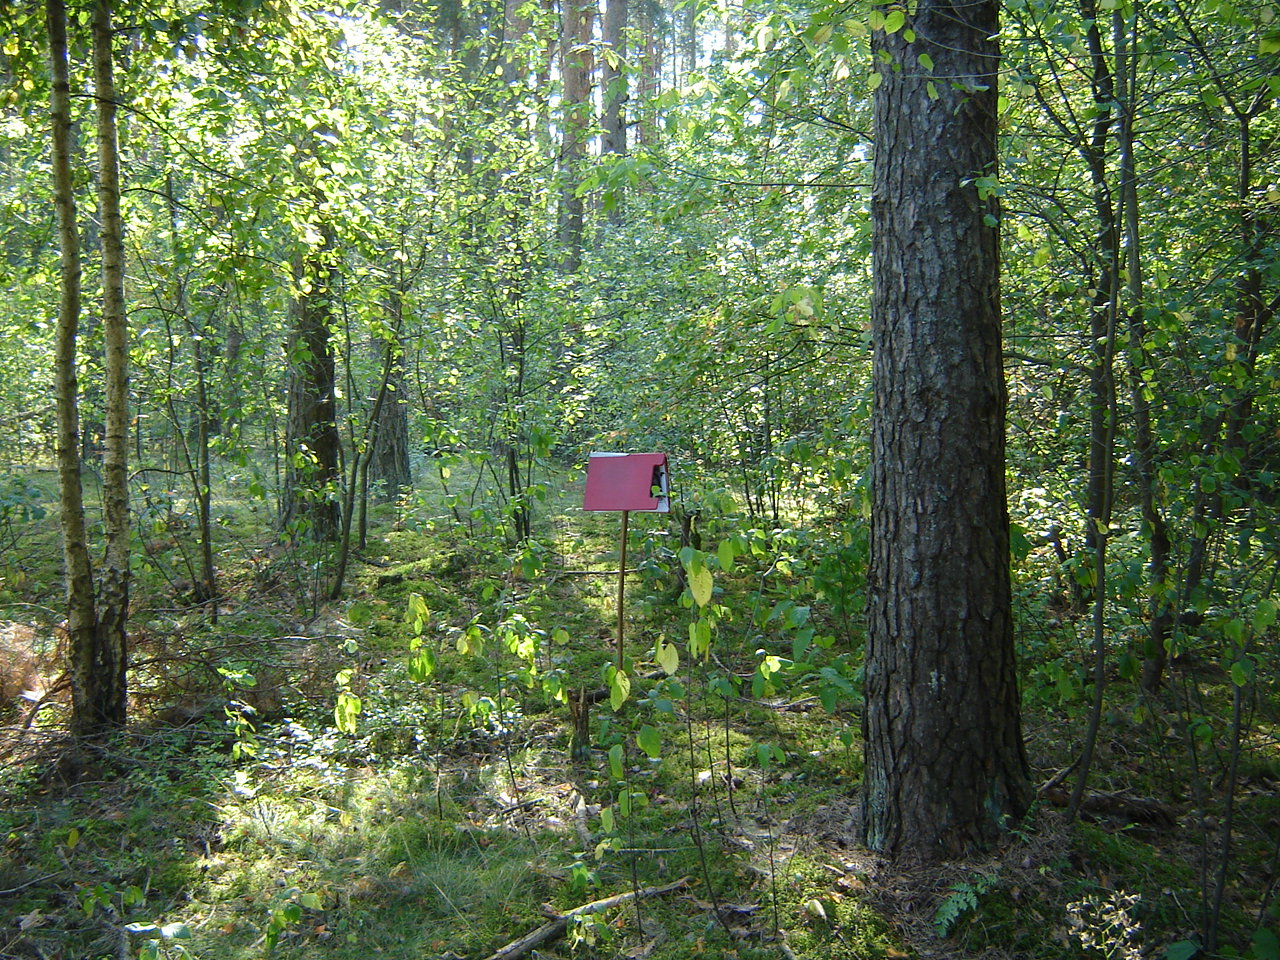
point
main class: Woodland
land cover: Pine dominated coniferous woodland
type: hemiboreal forest and nemoral coniferous forest and mixed broadleaved-coniferous forest
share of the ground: > 75 %
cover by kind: coniferous forest trees 80 %, broadleaved forest trees 5 %, shrubs 5 %, herbaceous plants 5 %, lichens and mosses 5 %
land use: Forestry
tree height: > 5 m
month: August
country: LT
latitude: 54.8785
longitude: 24.8386
